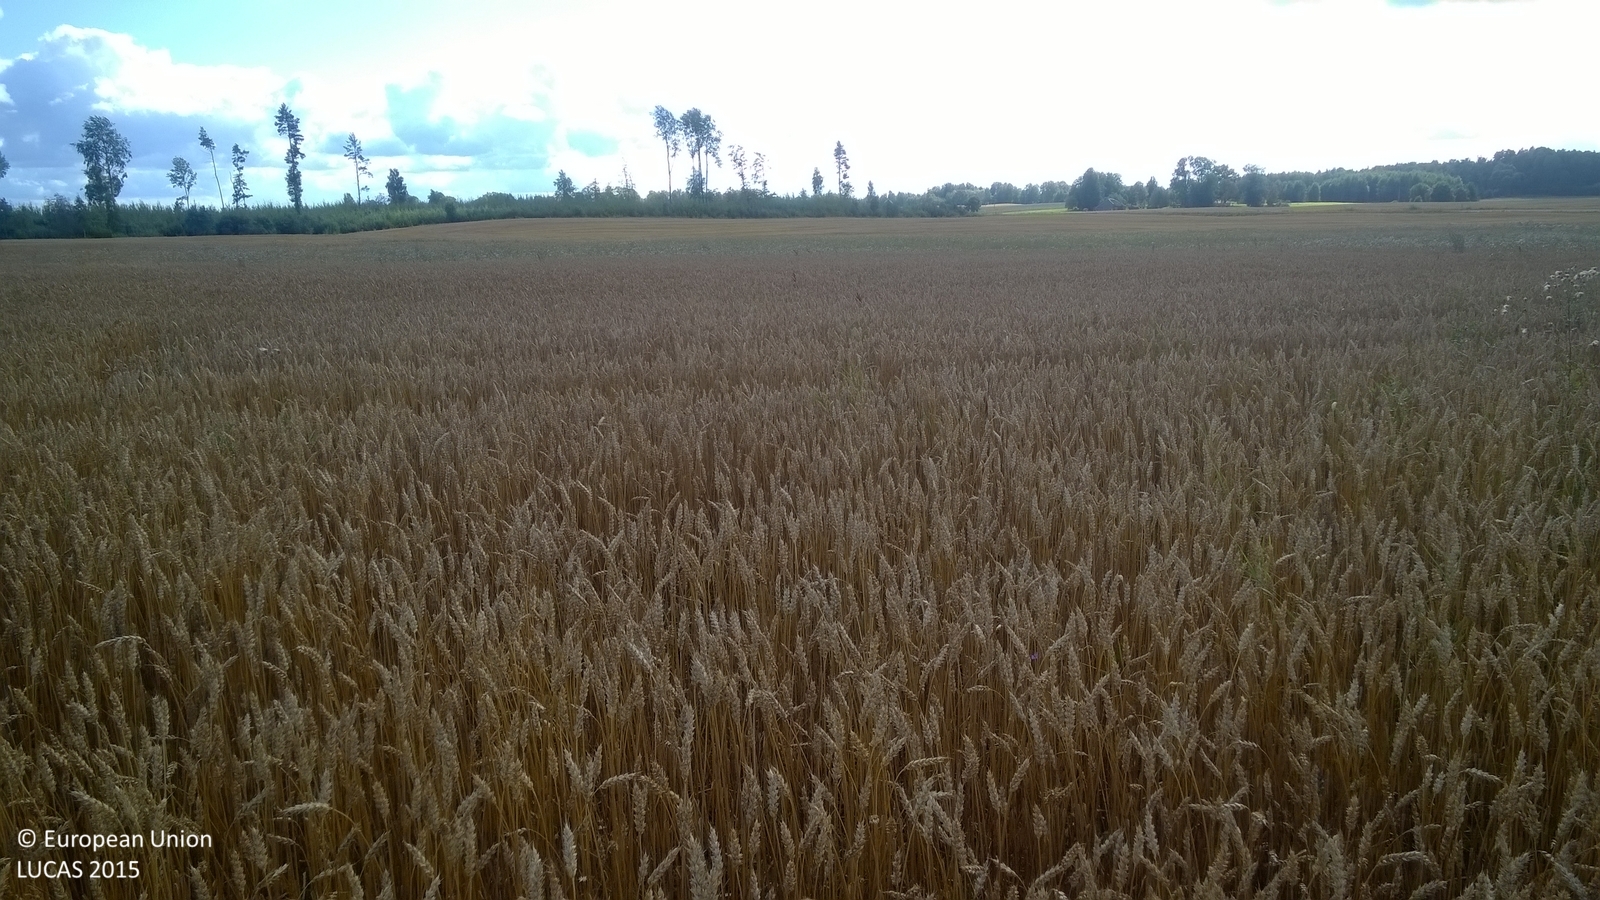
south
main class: Cropland
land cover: Common wheat
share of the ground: > 75 %
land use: Agriculture (excluding fallow land and kitchen gardens)
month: August
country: LV
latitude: 57.3904
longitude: 25.9155
